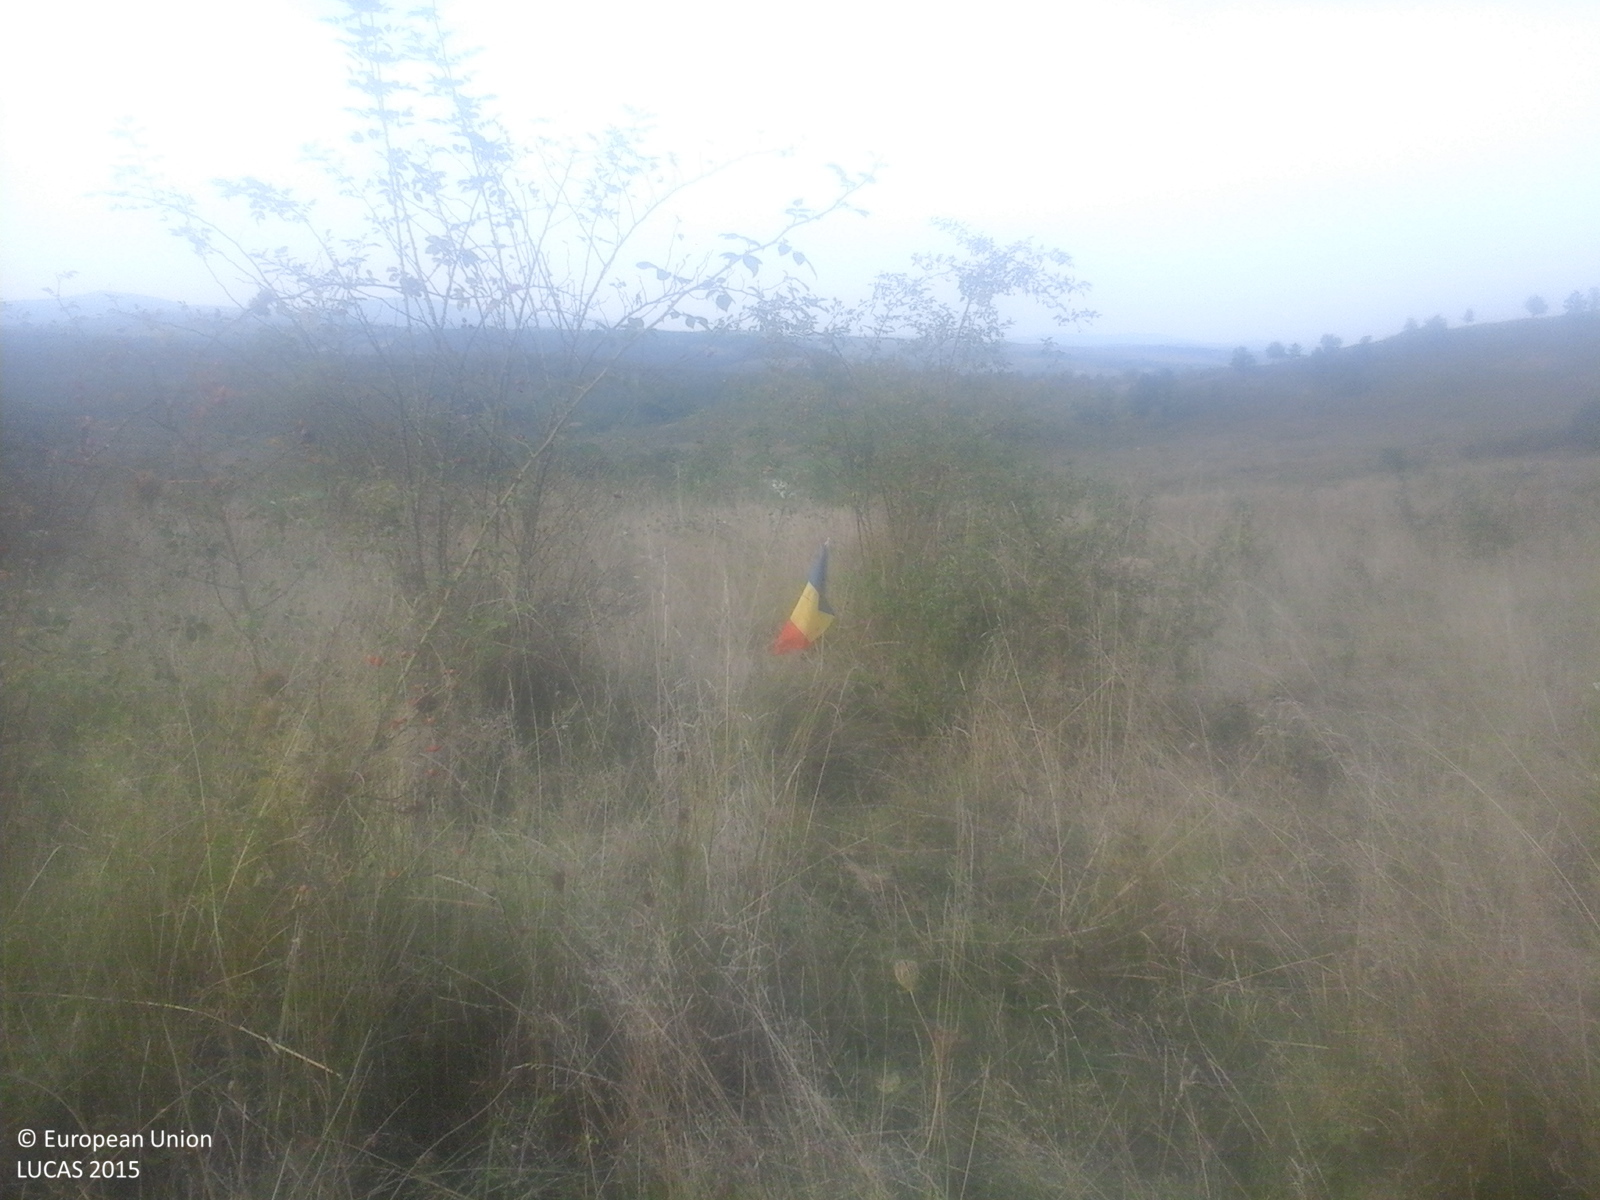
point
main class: Shrubland
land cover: Shrubland without tree cover
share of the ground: > 75 %
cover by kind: shrubs 60 %, herbaceous plants 40 %
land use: Agriculture (excluding fallow land and kitchen gardens)
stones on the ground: < 10 %
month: September
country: RO
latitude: 47.0328
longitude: 23.1317
